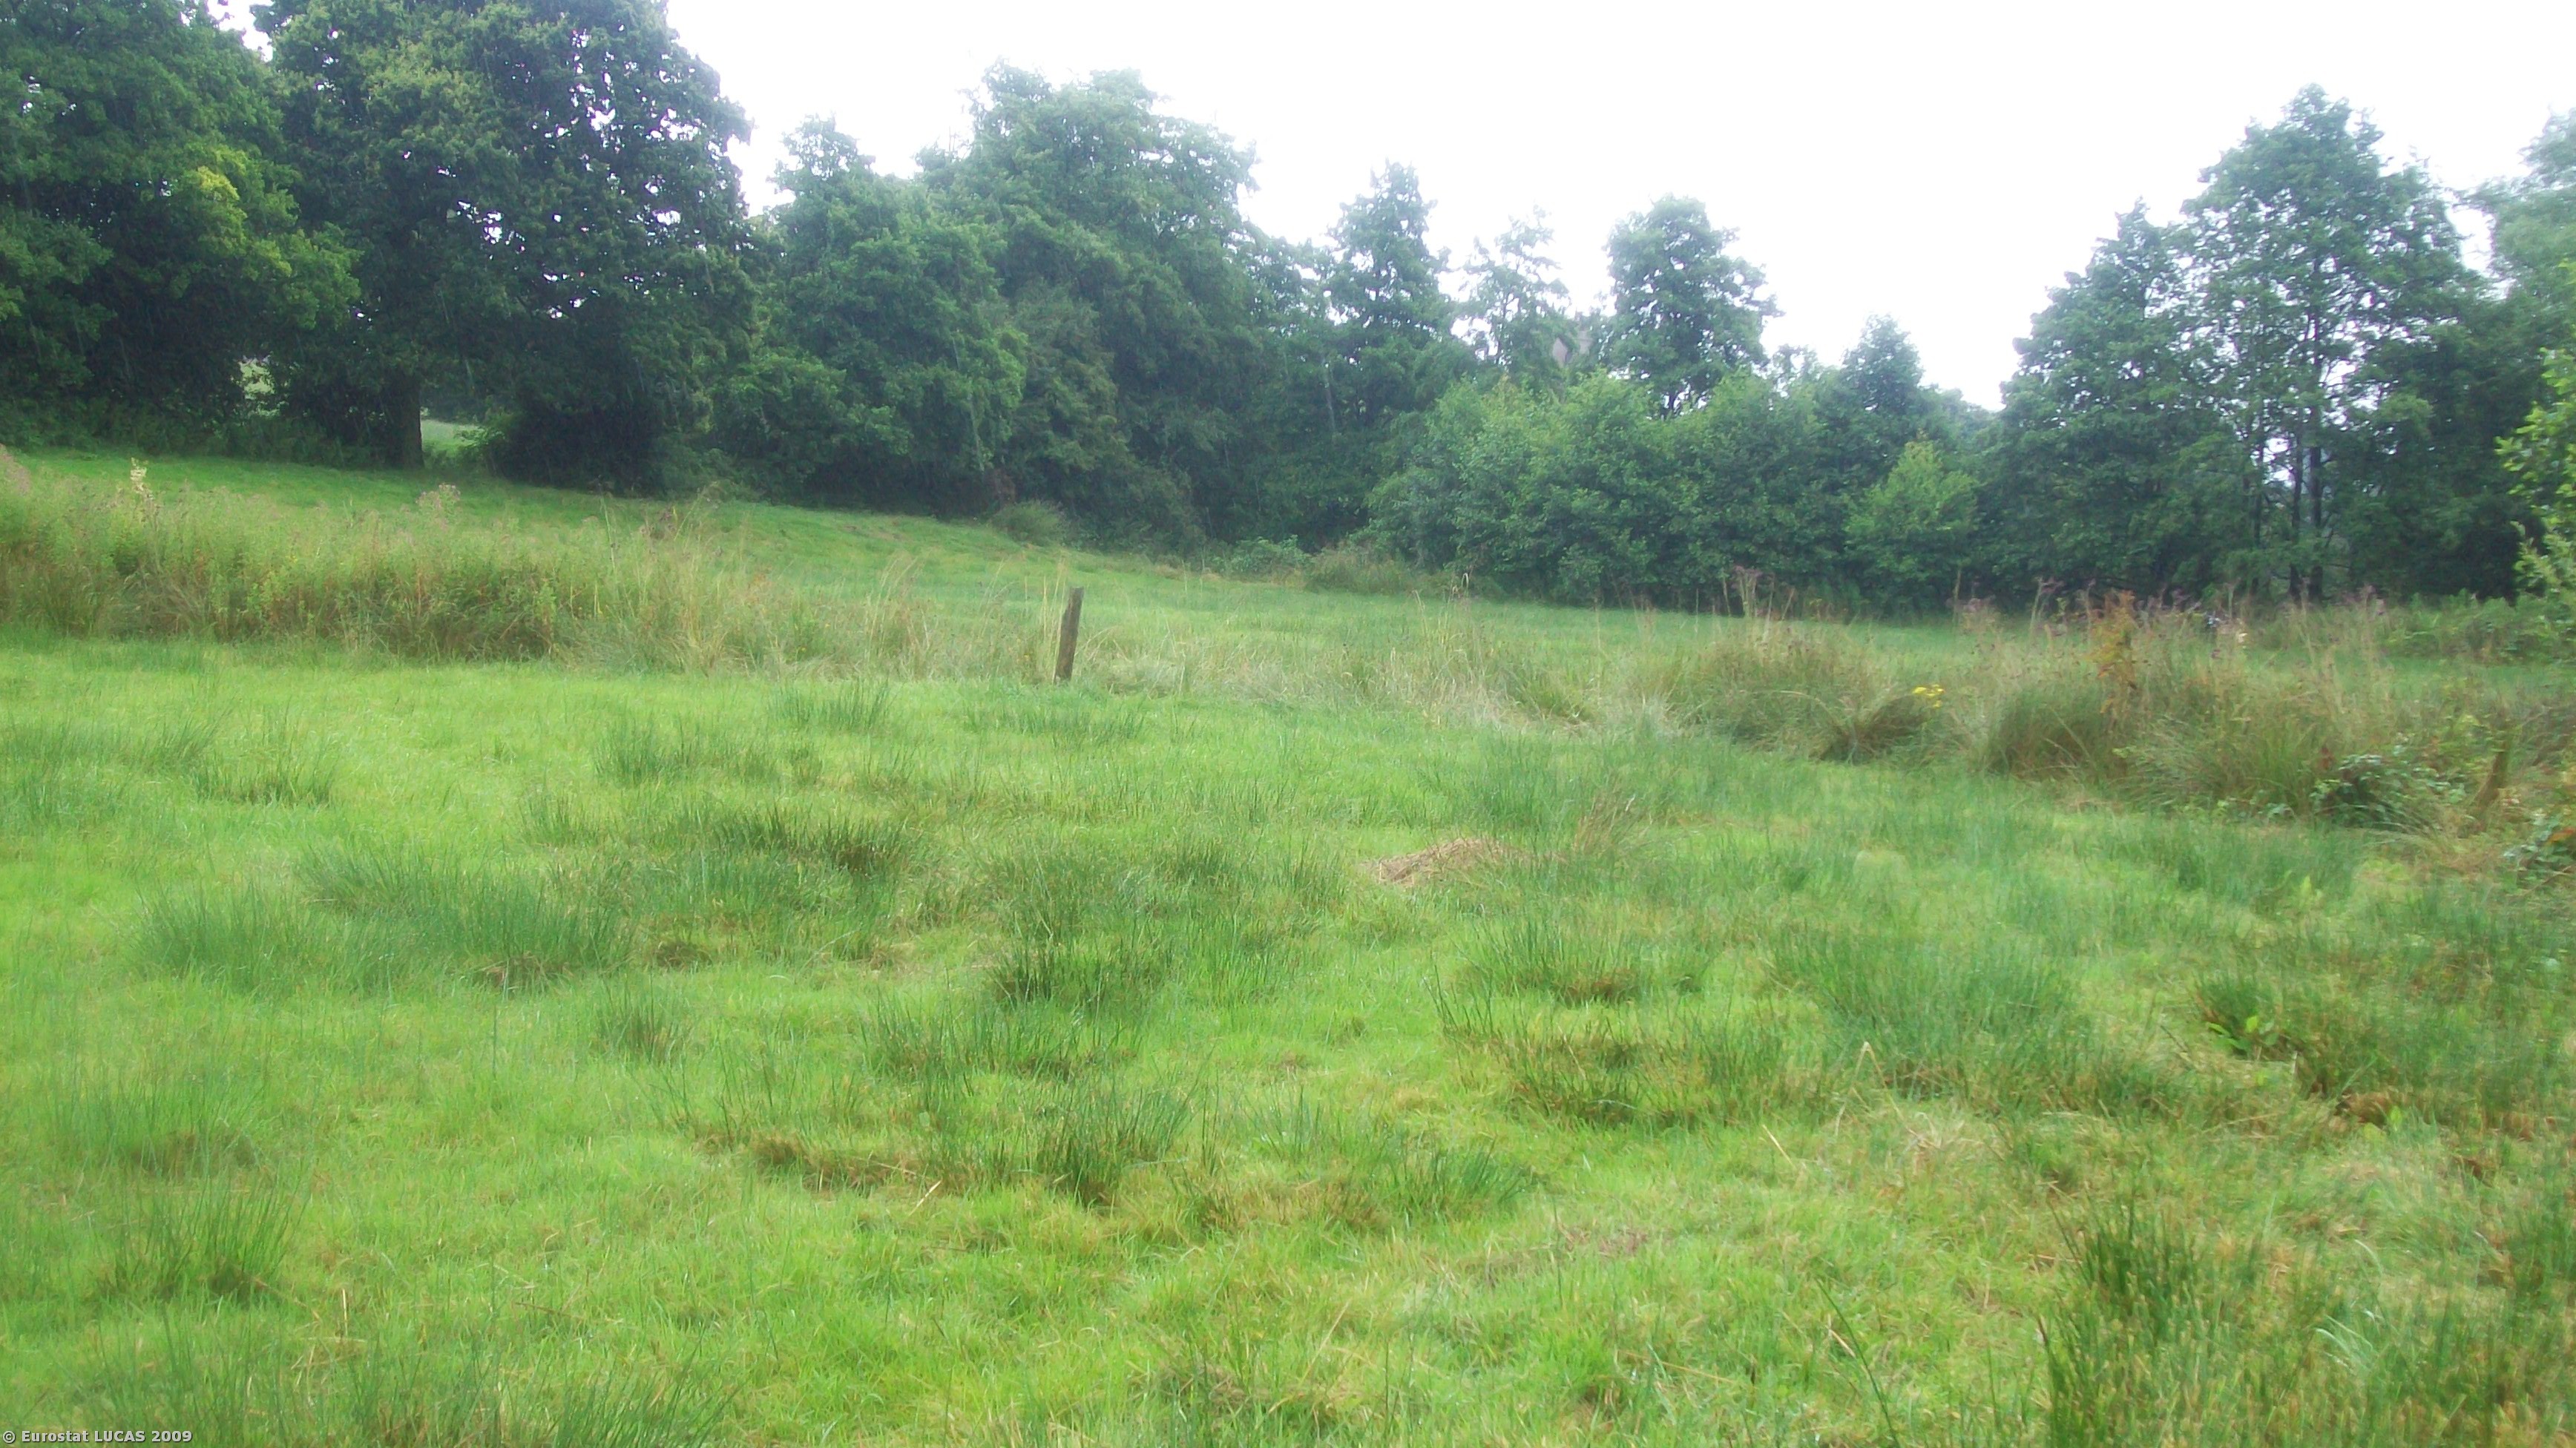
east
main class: Woodland
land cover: Broadleaved woodland
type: non-riverine alder, birch or aspen forest
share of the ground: > 75 %
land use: Unused
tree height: > 5 m
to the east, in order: Broadleaved woodland; Shrubland without tree cover; Grassland without tree/shrub cover; Broadleaved woodland; Grassland without tree/shrub cover; Fences; Grassland without tree/shrub cover
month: July
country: GB
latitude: 53.0070
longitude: -2.6617
